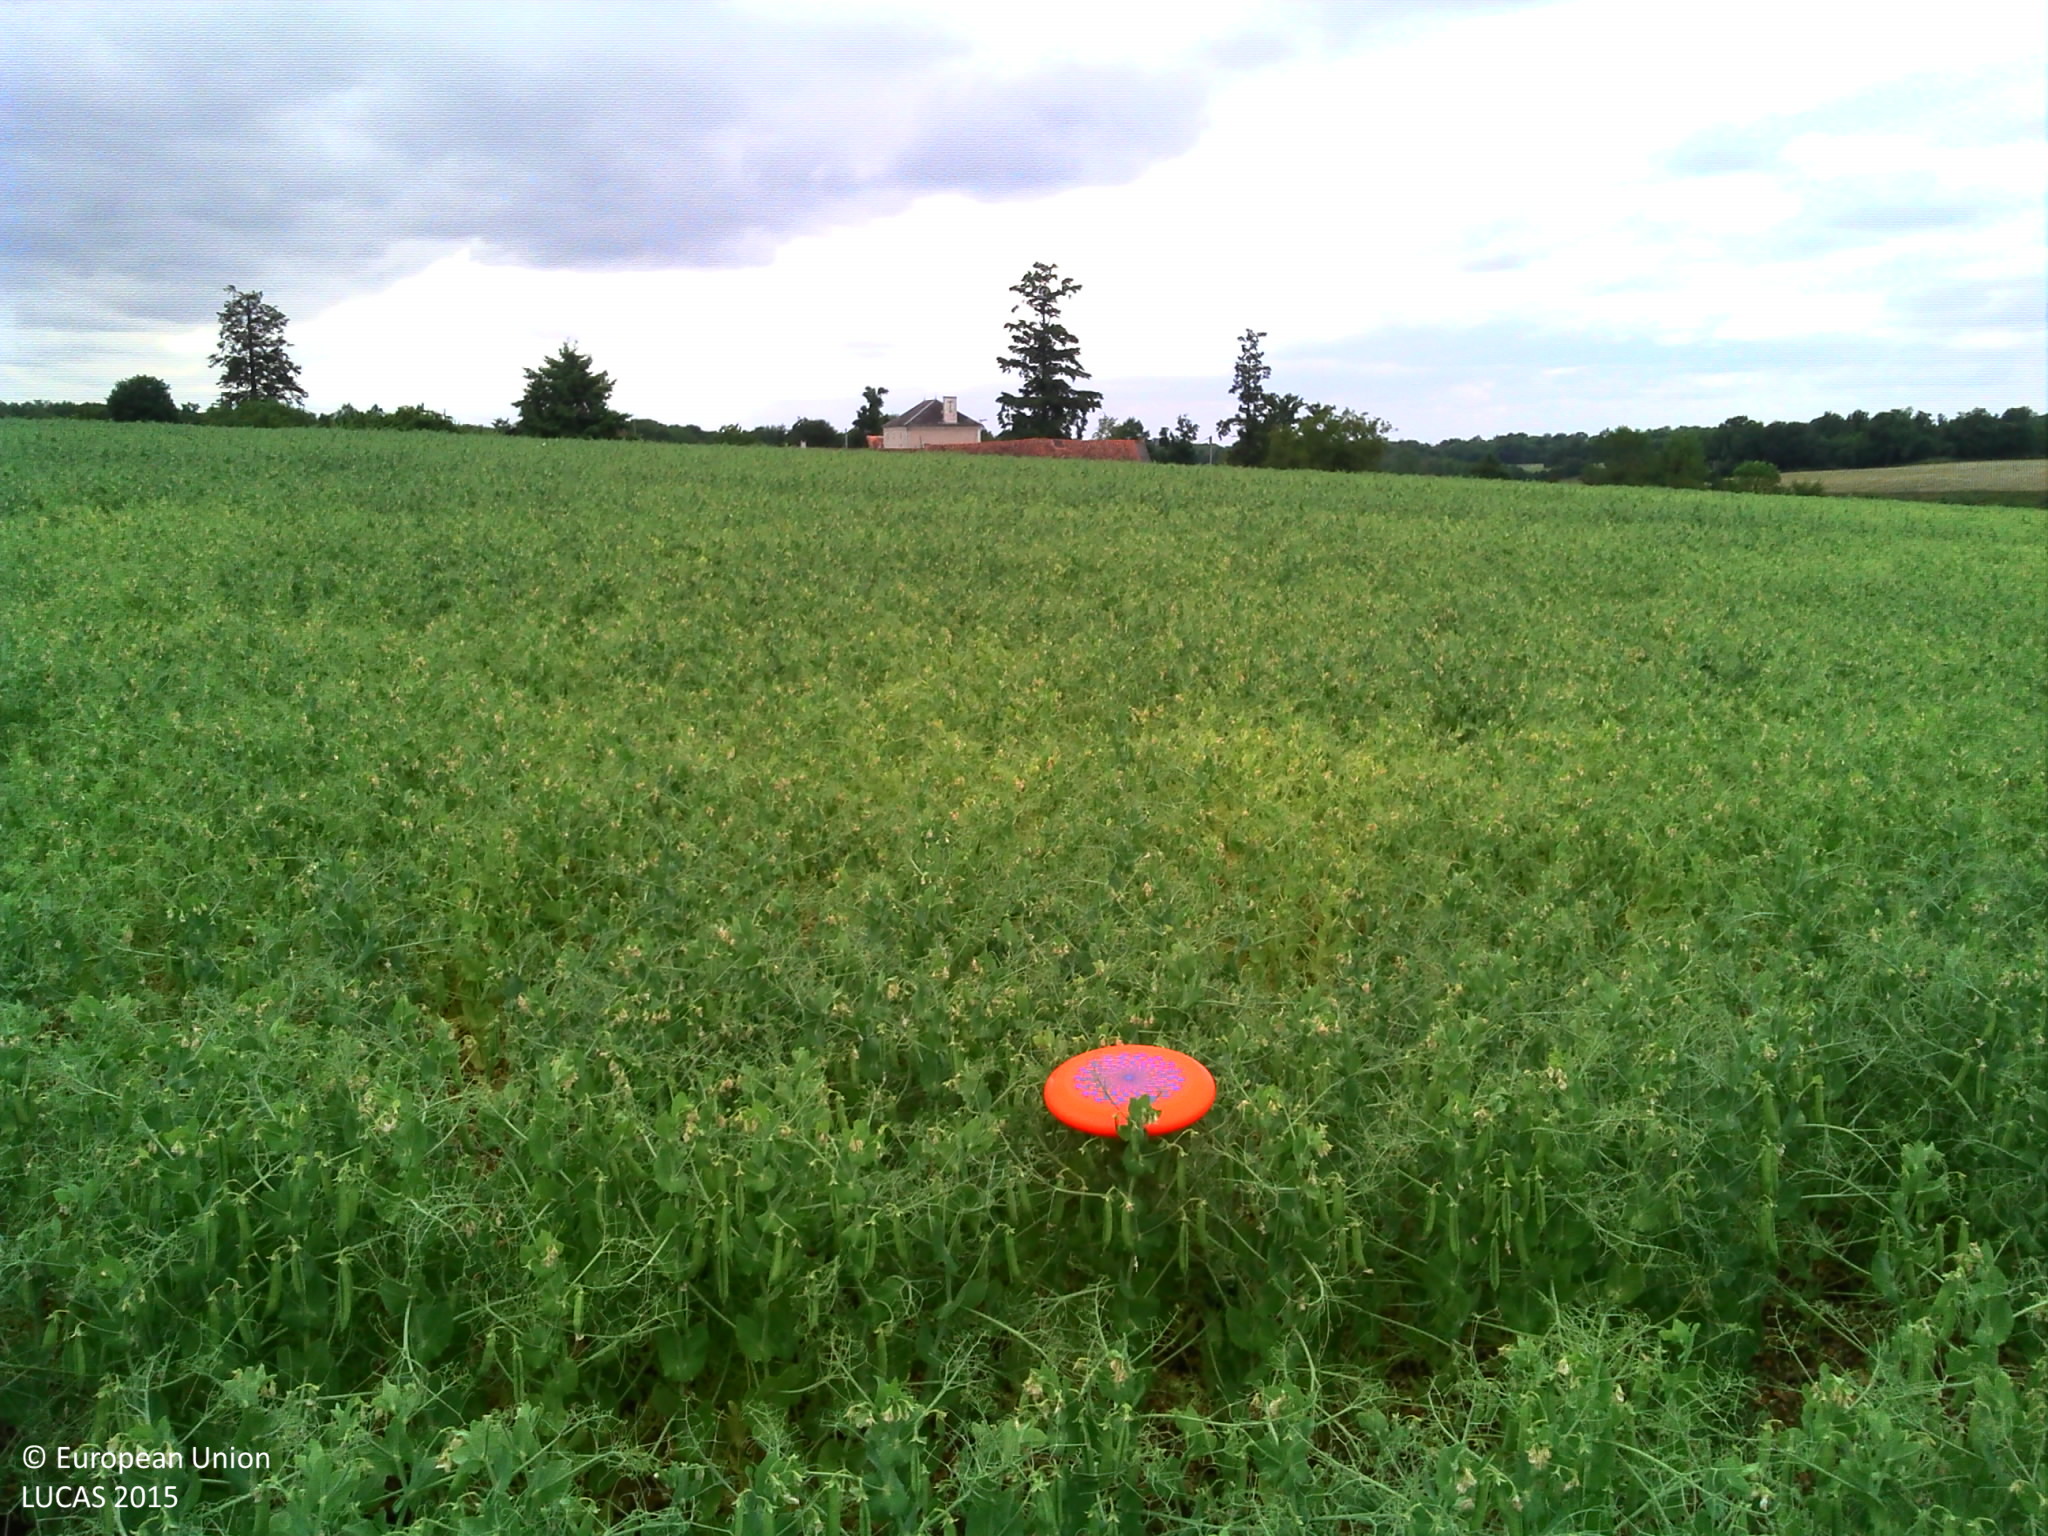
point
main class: Cropland
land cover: Dry pulses
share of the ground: > 75 %
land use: Agriculture (excluding fallow land and kitchen gardens)
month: June
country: FR
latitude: 46.0368
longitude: 0.3052
